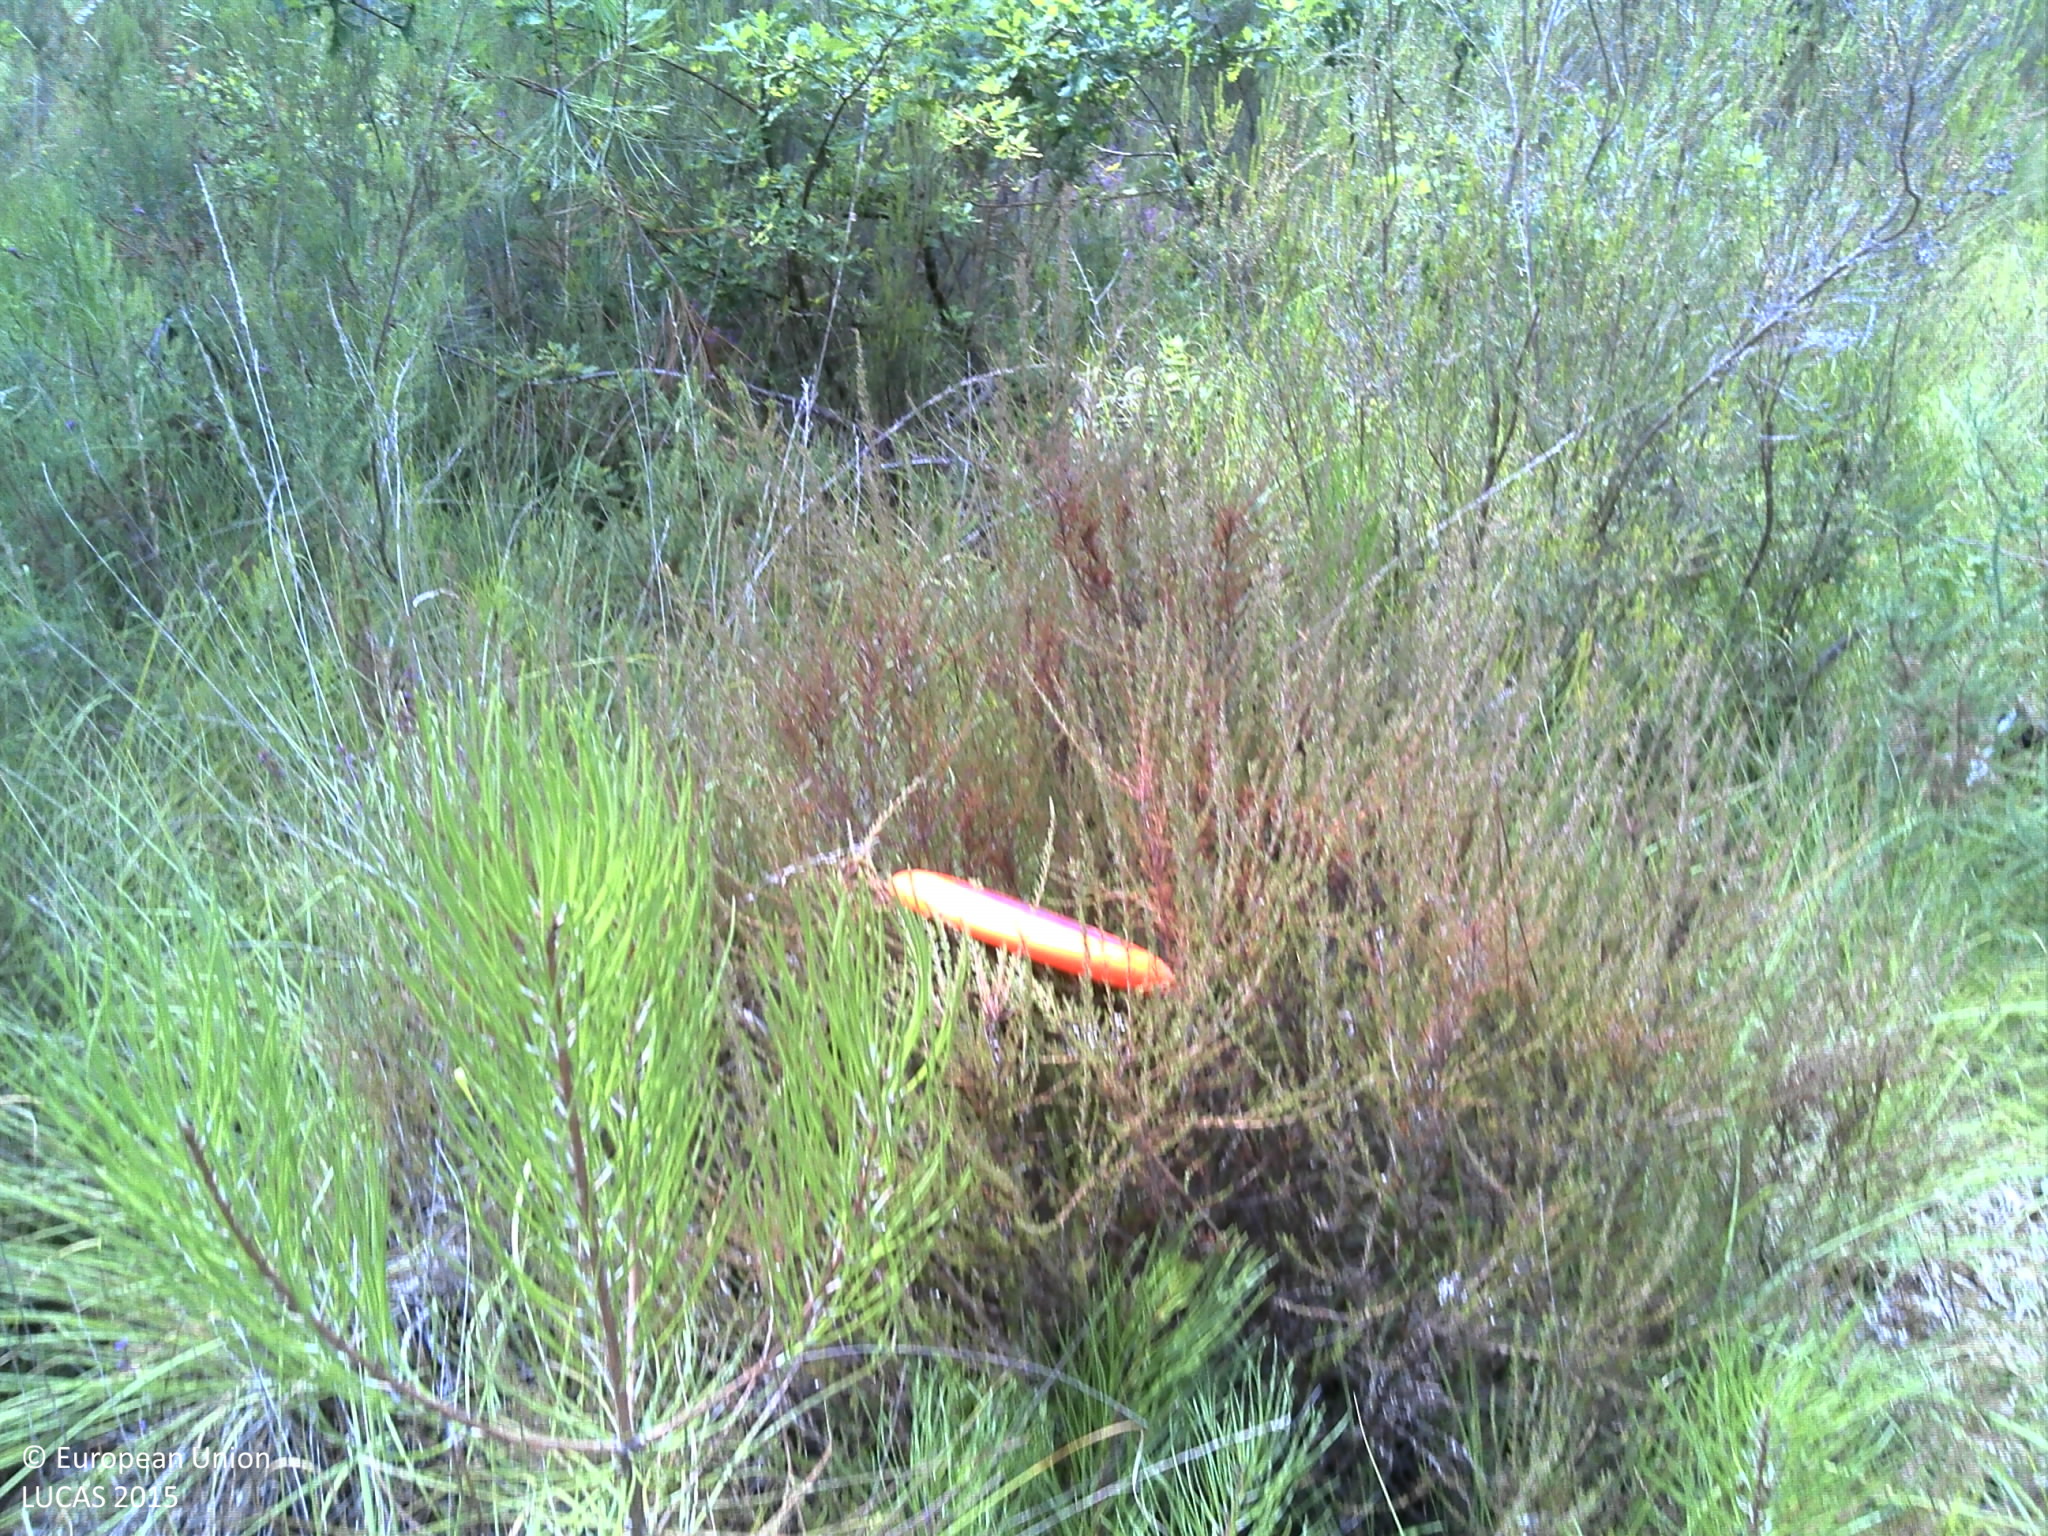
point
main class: Woodland
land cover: Pine dominated coniferous woodland
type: coniferous forest of the mediterranean region
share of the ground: > 75 %
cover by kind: coniferous forest trees 60 %, shrubs 25 %, broadleaved forest trees 10 %, herbaceous plants 5 %
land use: Forestry
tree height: < 5 m
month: August
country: FR
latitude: 44.8584
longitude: -0.9688
